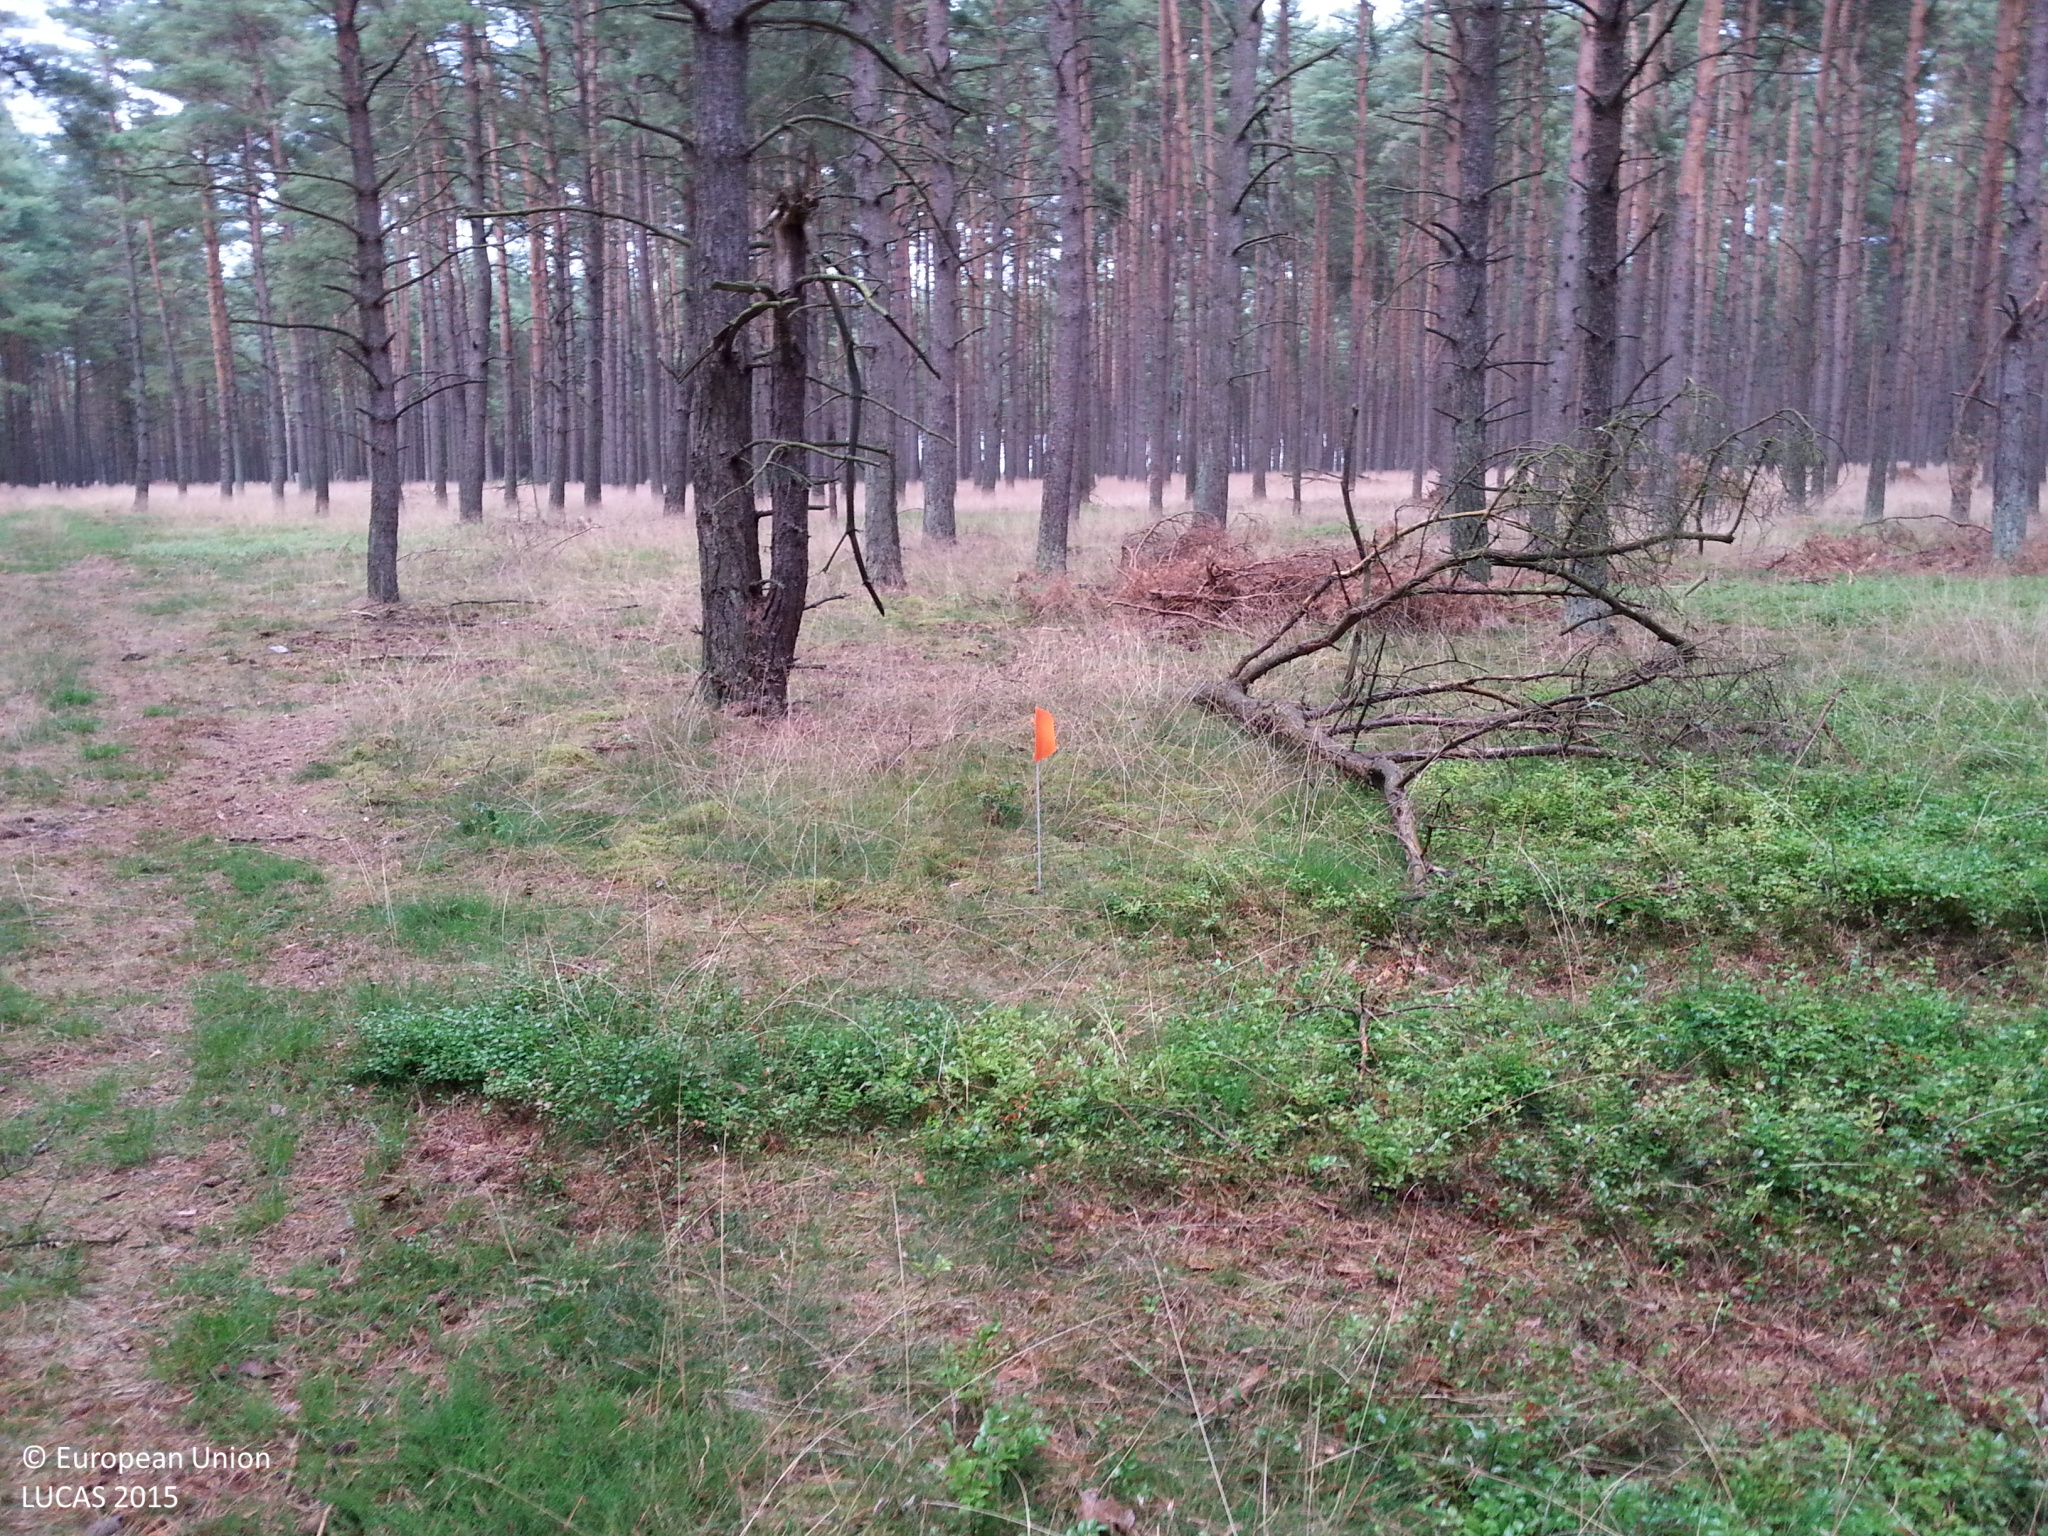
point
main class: Woodland
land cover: Pine dominated coniferous woodland
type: hemiboreal forest and nemoral coniferous forest and mixed broadleaved-coniferous forest
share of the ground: 50 - 75 %
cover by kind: coniferous forest trees 50 %, herbaceous plants 35 %, lichens and mosses 15 %
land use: Forestry
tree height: > 5 m
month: July
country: DE
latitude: 53.1095
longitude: 12.3447
